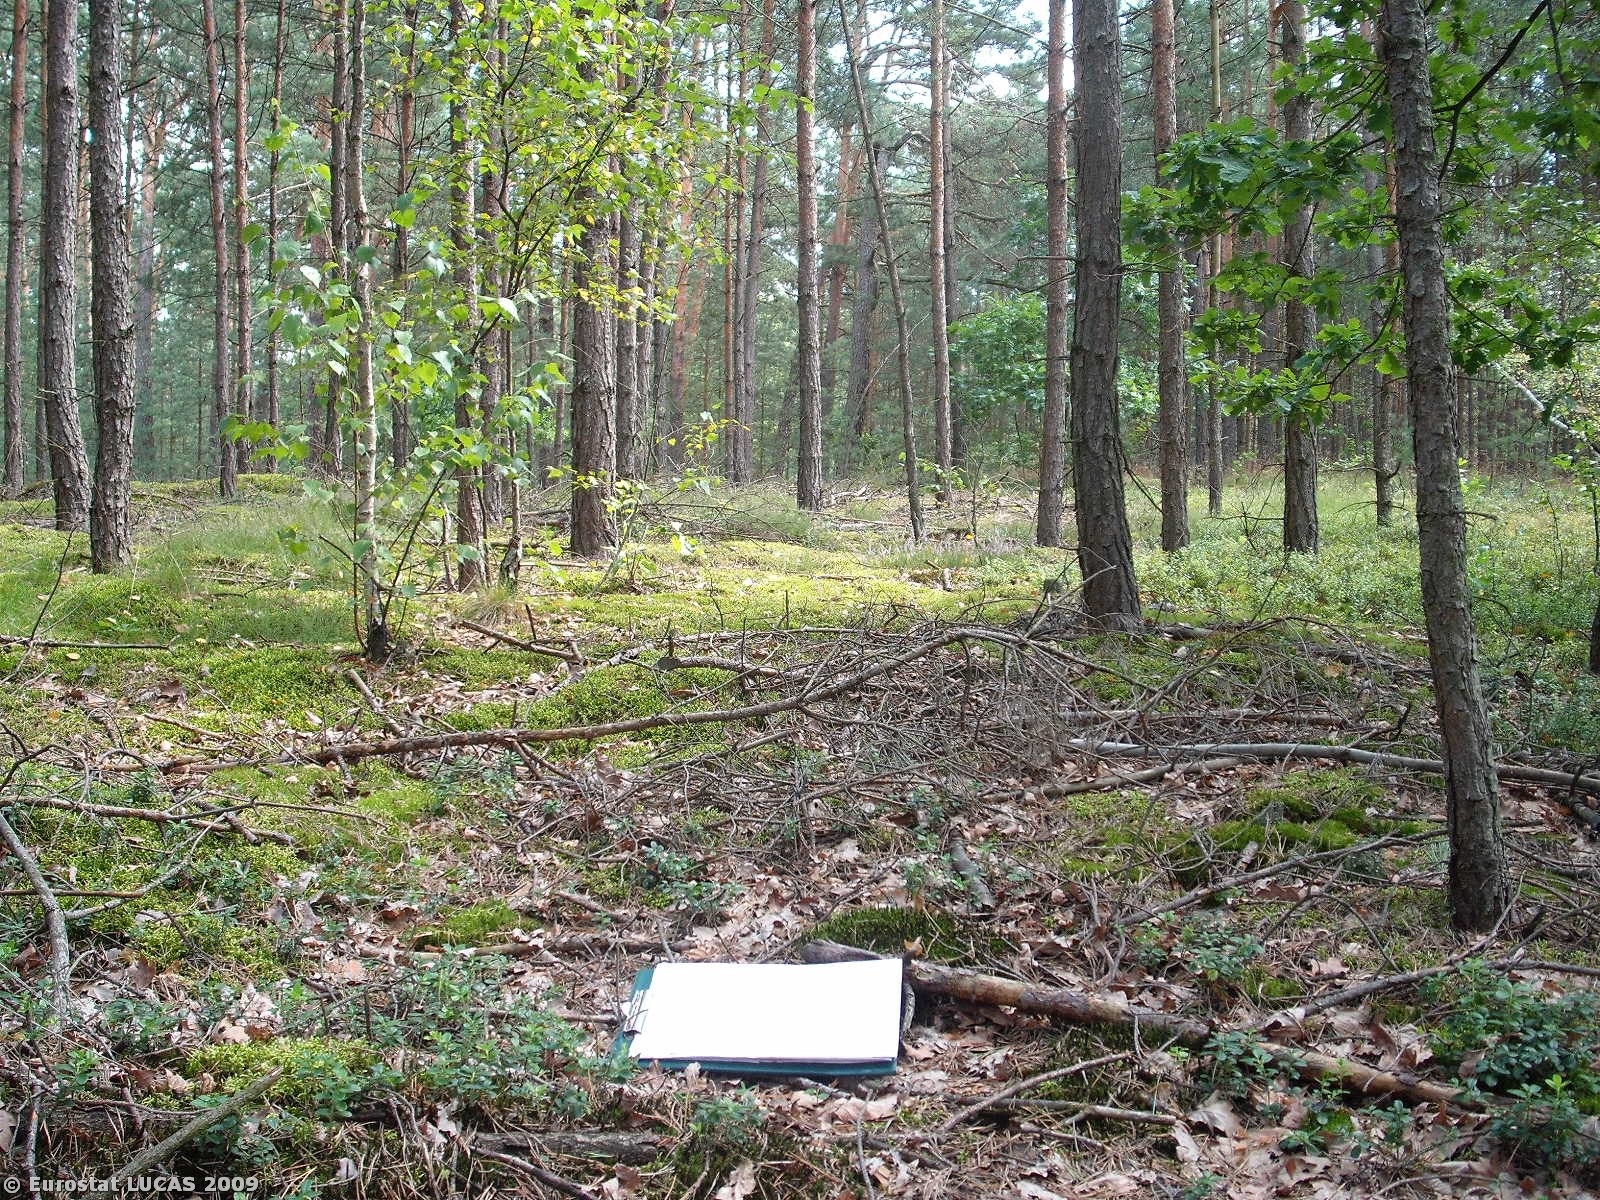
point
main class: Woodland
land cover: Coniferous woodland
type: hemiboreal forest and nemoral coniferous forest and mixed broadleaved-coniferous forest
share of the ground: > 75 %
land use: Forestry
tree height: > 5 m
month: August
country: PL
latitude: 51.7757
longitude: 21.5450
